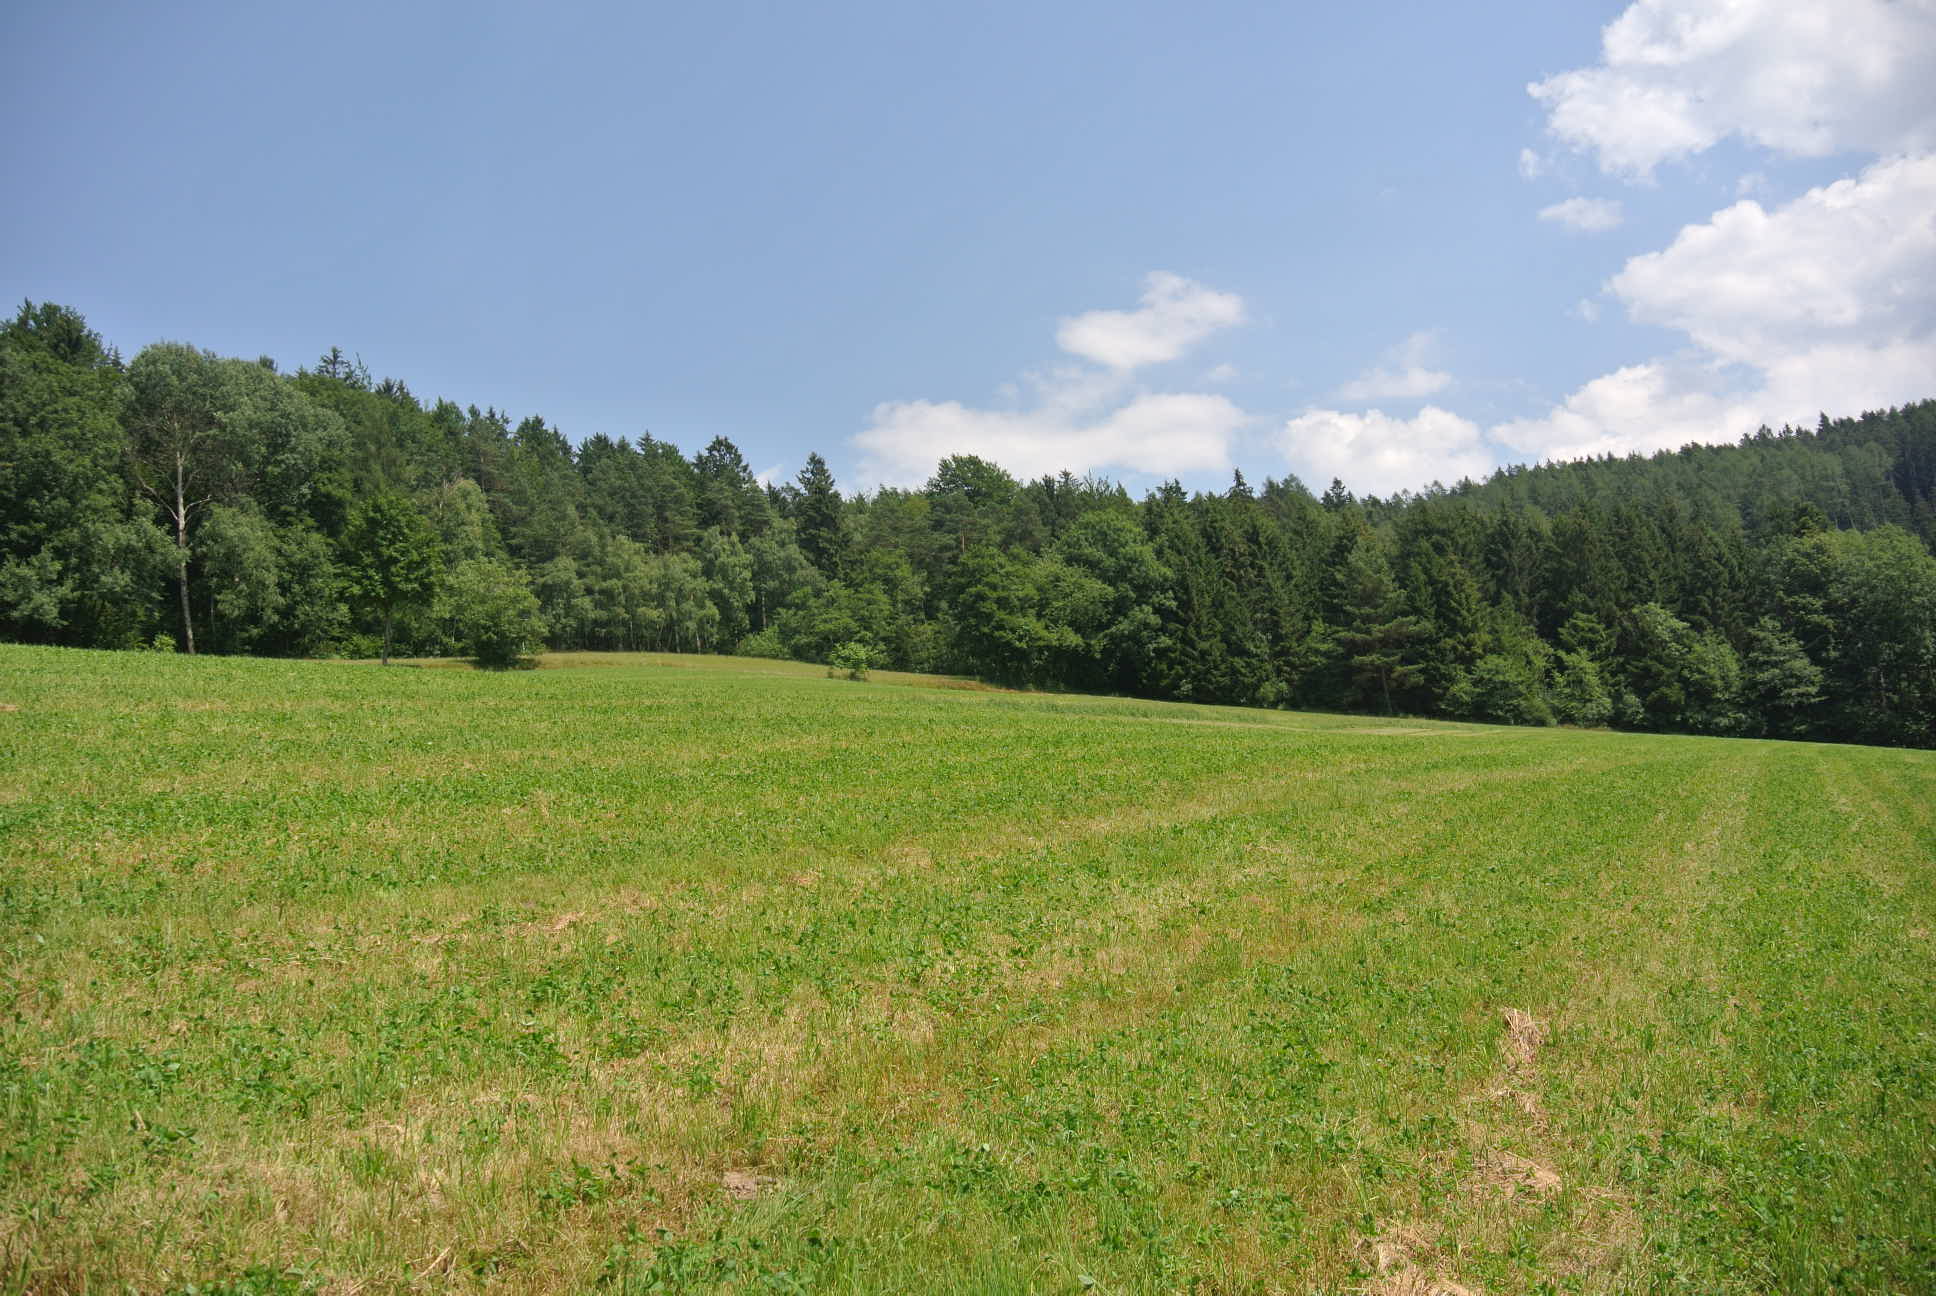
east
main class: Grassland
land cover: Grassland without tree/shrub cover
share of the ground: > 75 %
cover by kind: herbaceous plants 100 %
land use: Agriculture (excluding fallow land and kitchen gardens)
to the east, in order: Grassland without tree/shrub cover; Tracks; Grassland without tree/shrub cover; Spruce dominated mixed woodland
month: July
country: AT
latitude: 47.6179
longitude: 16.1632
